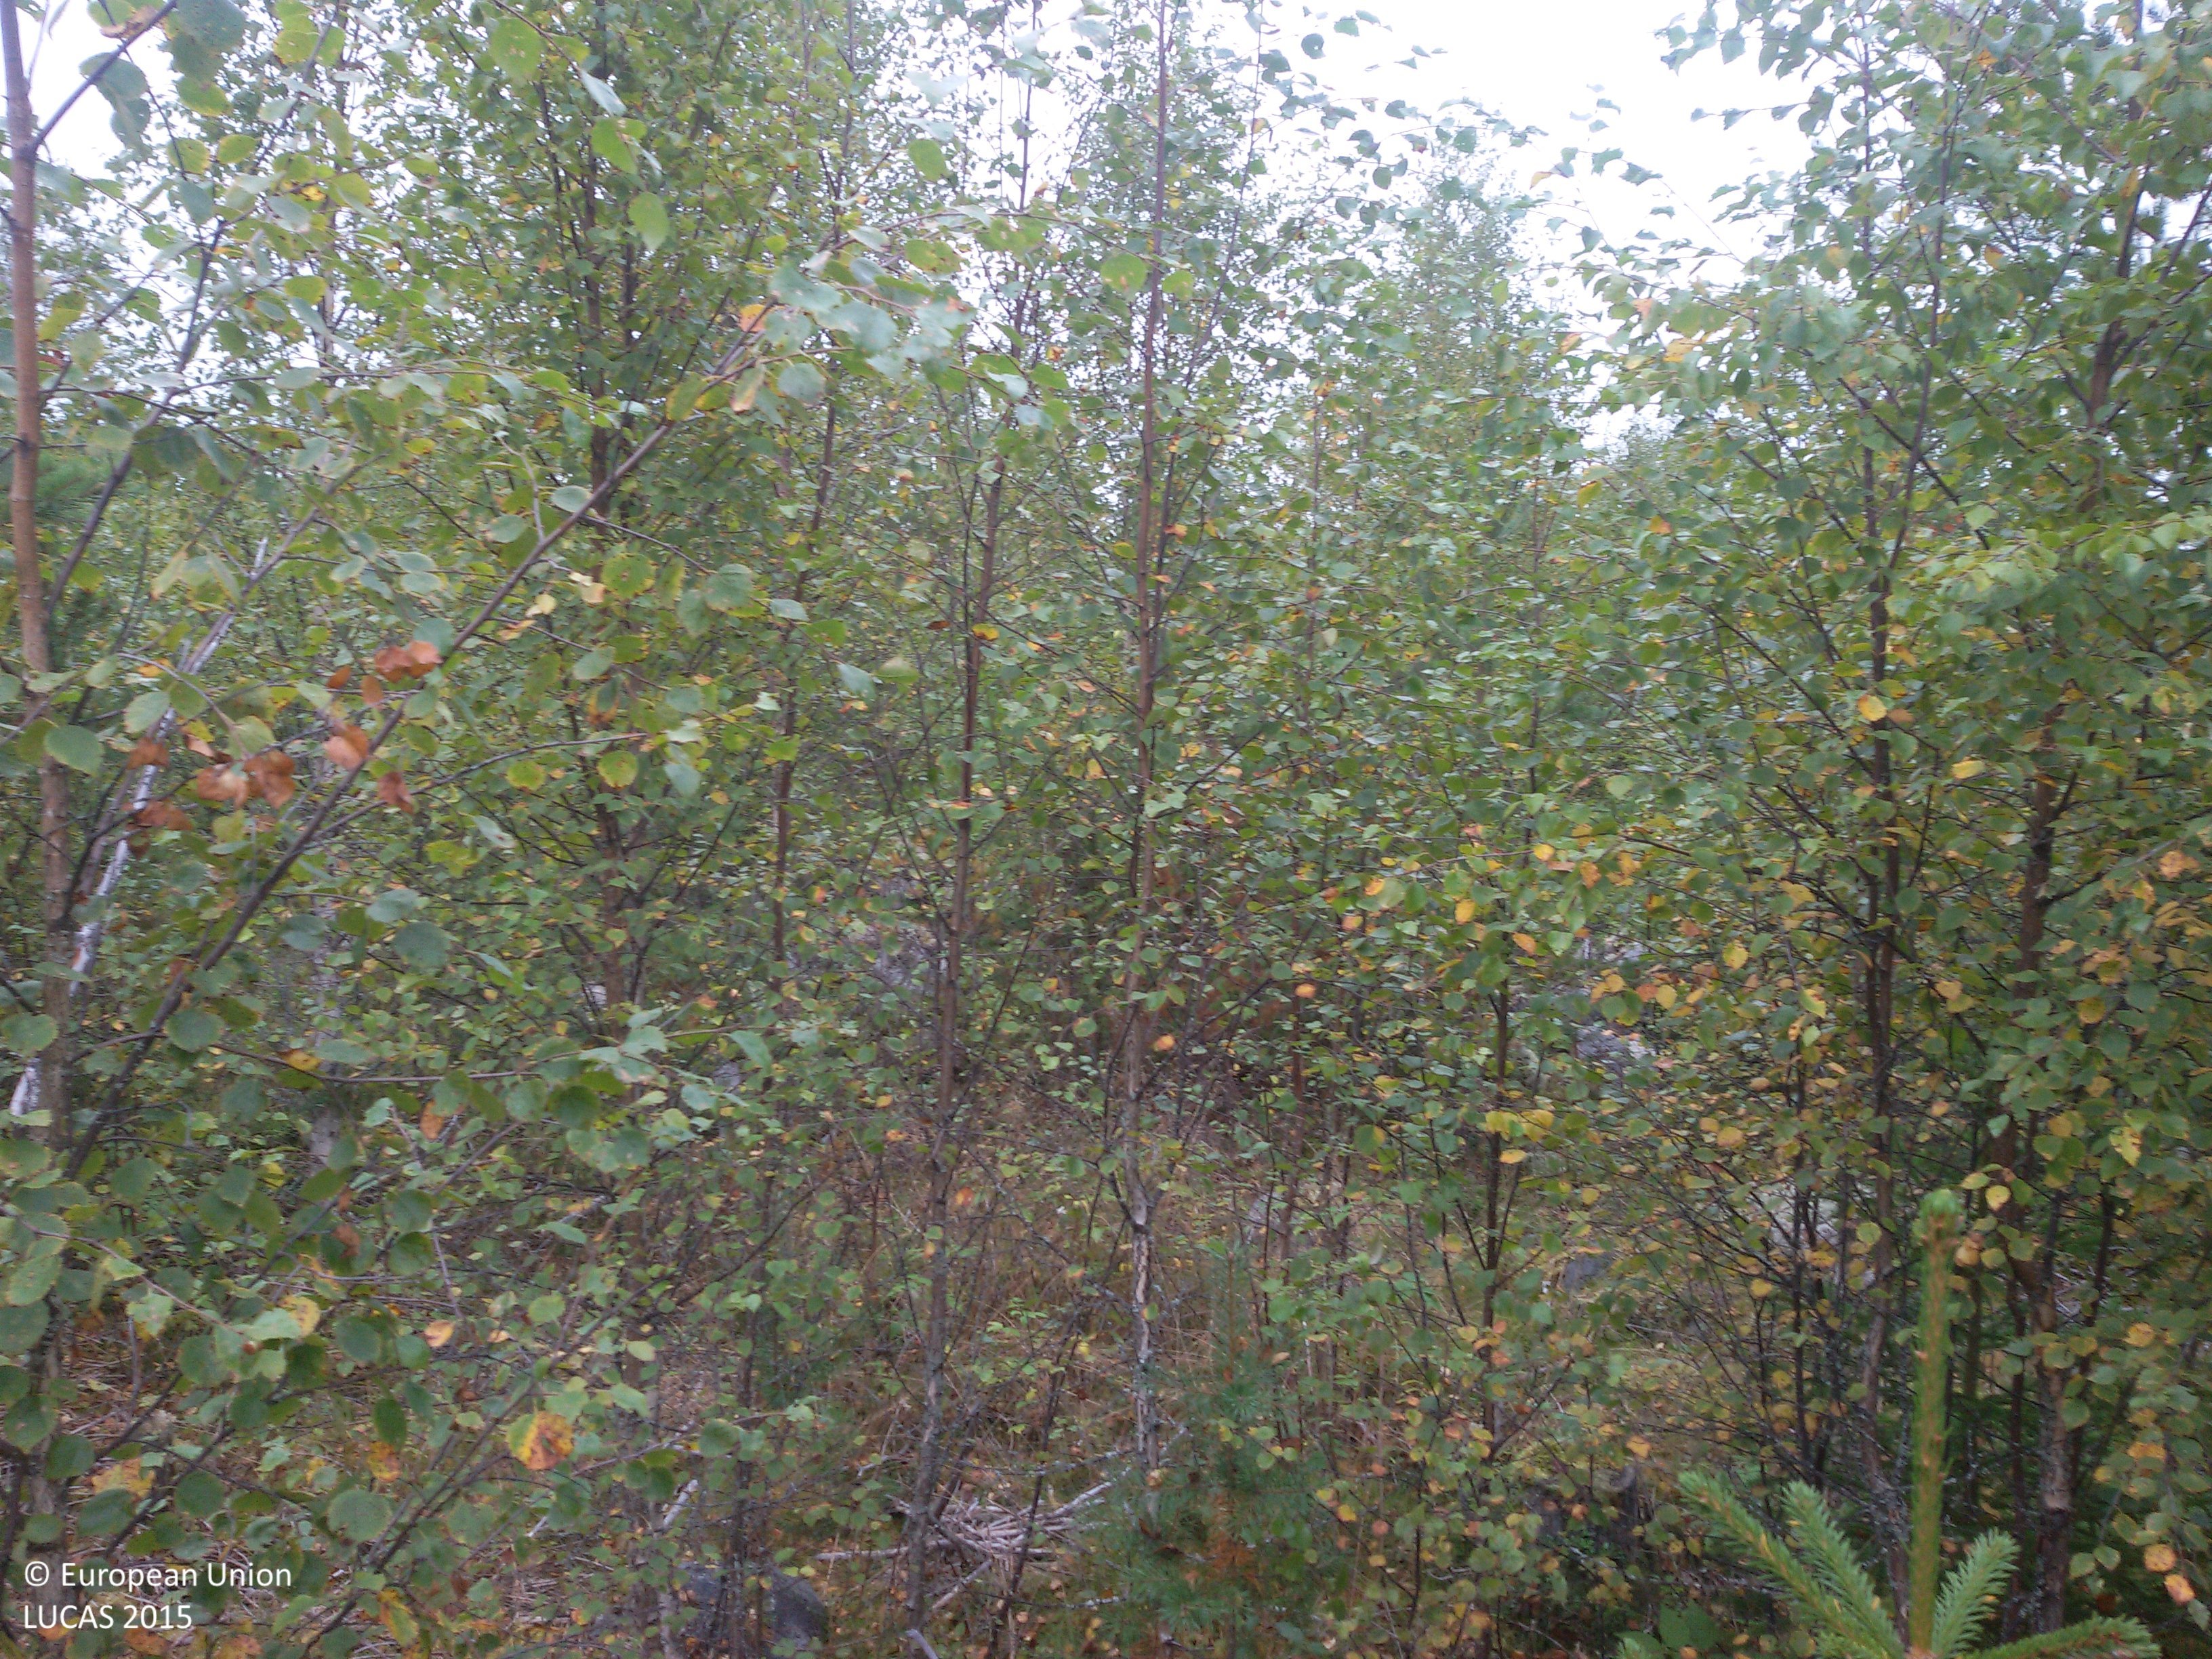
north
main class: Woodland
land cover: Pine dominated mixed woodland
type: boreal forest
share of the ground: 50 - 75 %
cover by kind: broadleaved forest trees 40 %, coniferous forest trees 30 %, herbaceous plants 20 %, lichens and mosses 10 %
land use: Forestry
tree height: < 5 m
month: September
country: SE
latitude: 60.8211
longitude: 15.3006
